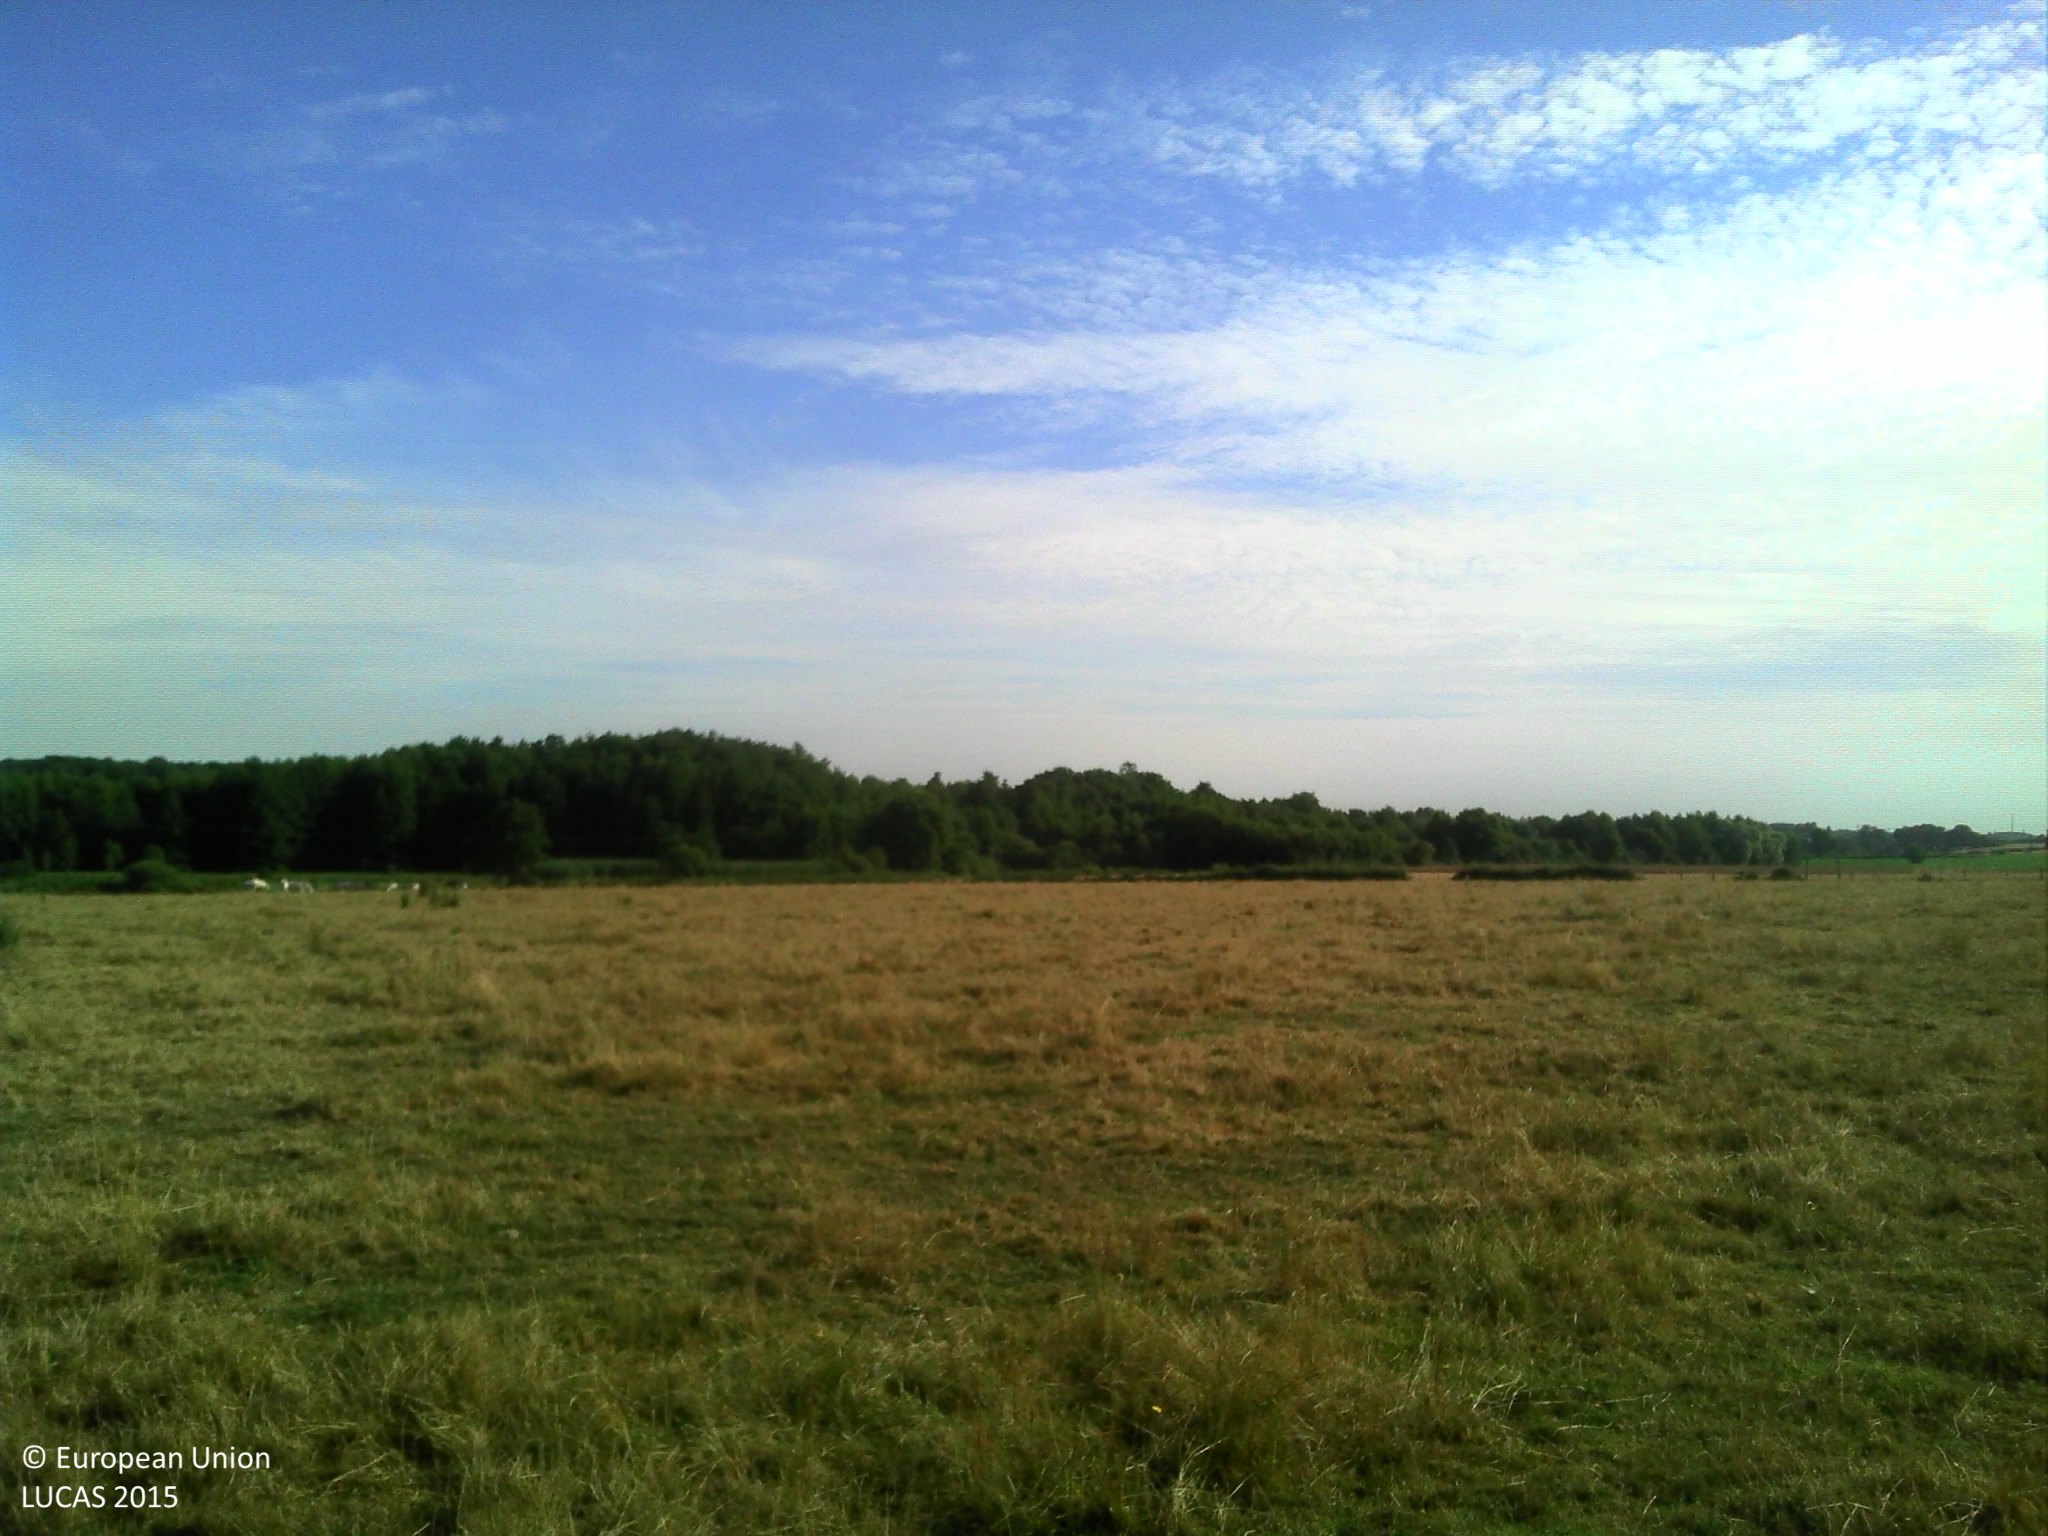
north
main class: Grassland
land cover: Grassland without tree/shrub cover
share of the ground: > 75 %
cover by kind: herbaceous plants 100 %
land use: Agriculture (excluding fallow land and kitchen gardens)
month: June
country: FR
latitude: 46.7303
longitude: 4.8064
